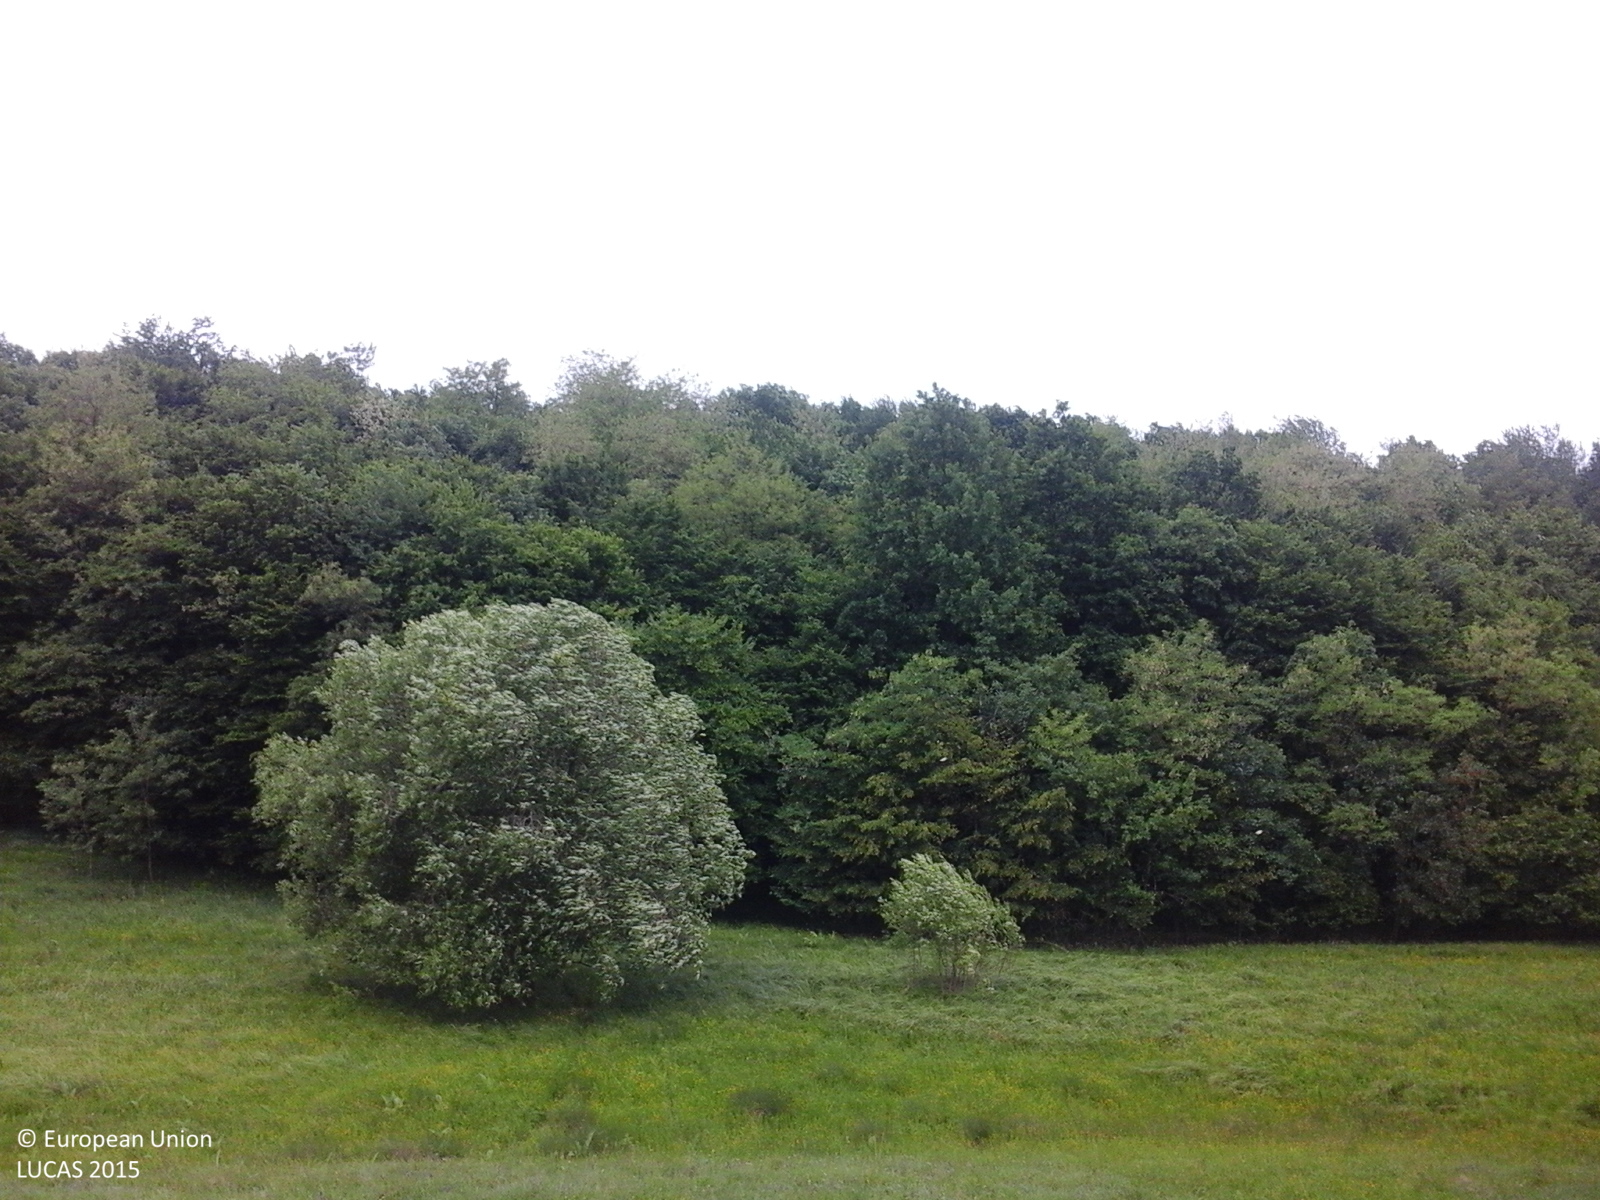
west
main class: Grassland
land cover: Grassland with sparse tree/shrub cover
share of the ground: > 75 %
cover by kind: herbaceous plants 90 %, broadleaved forest trees 5 %, shrubs 5 %
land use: Agriculture (excluding fallow land and kitchen gardens)
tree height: < 5 m
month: June
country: RO
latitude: 47.0144
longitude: 26.6786
